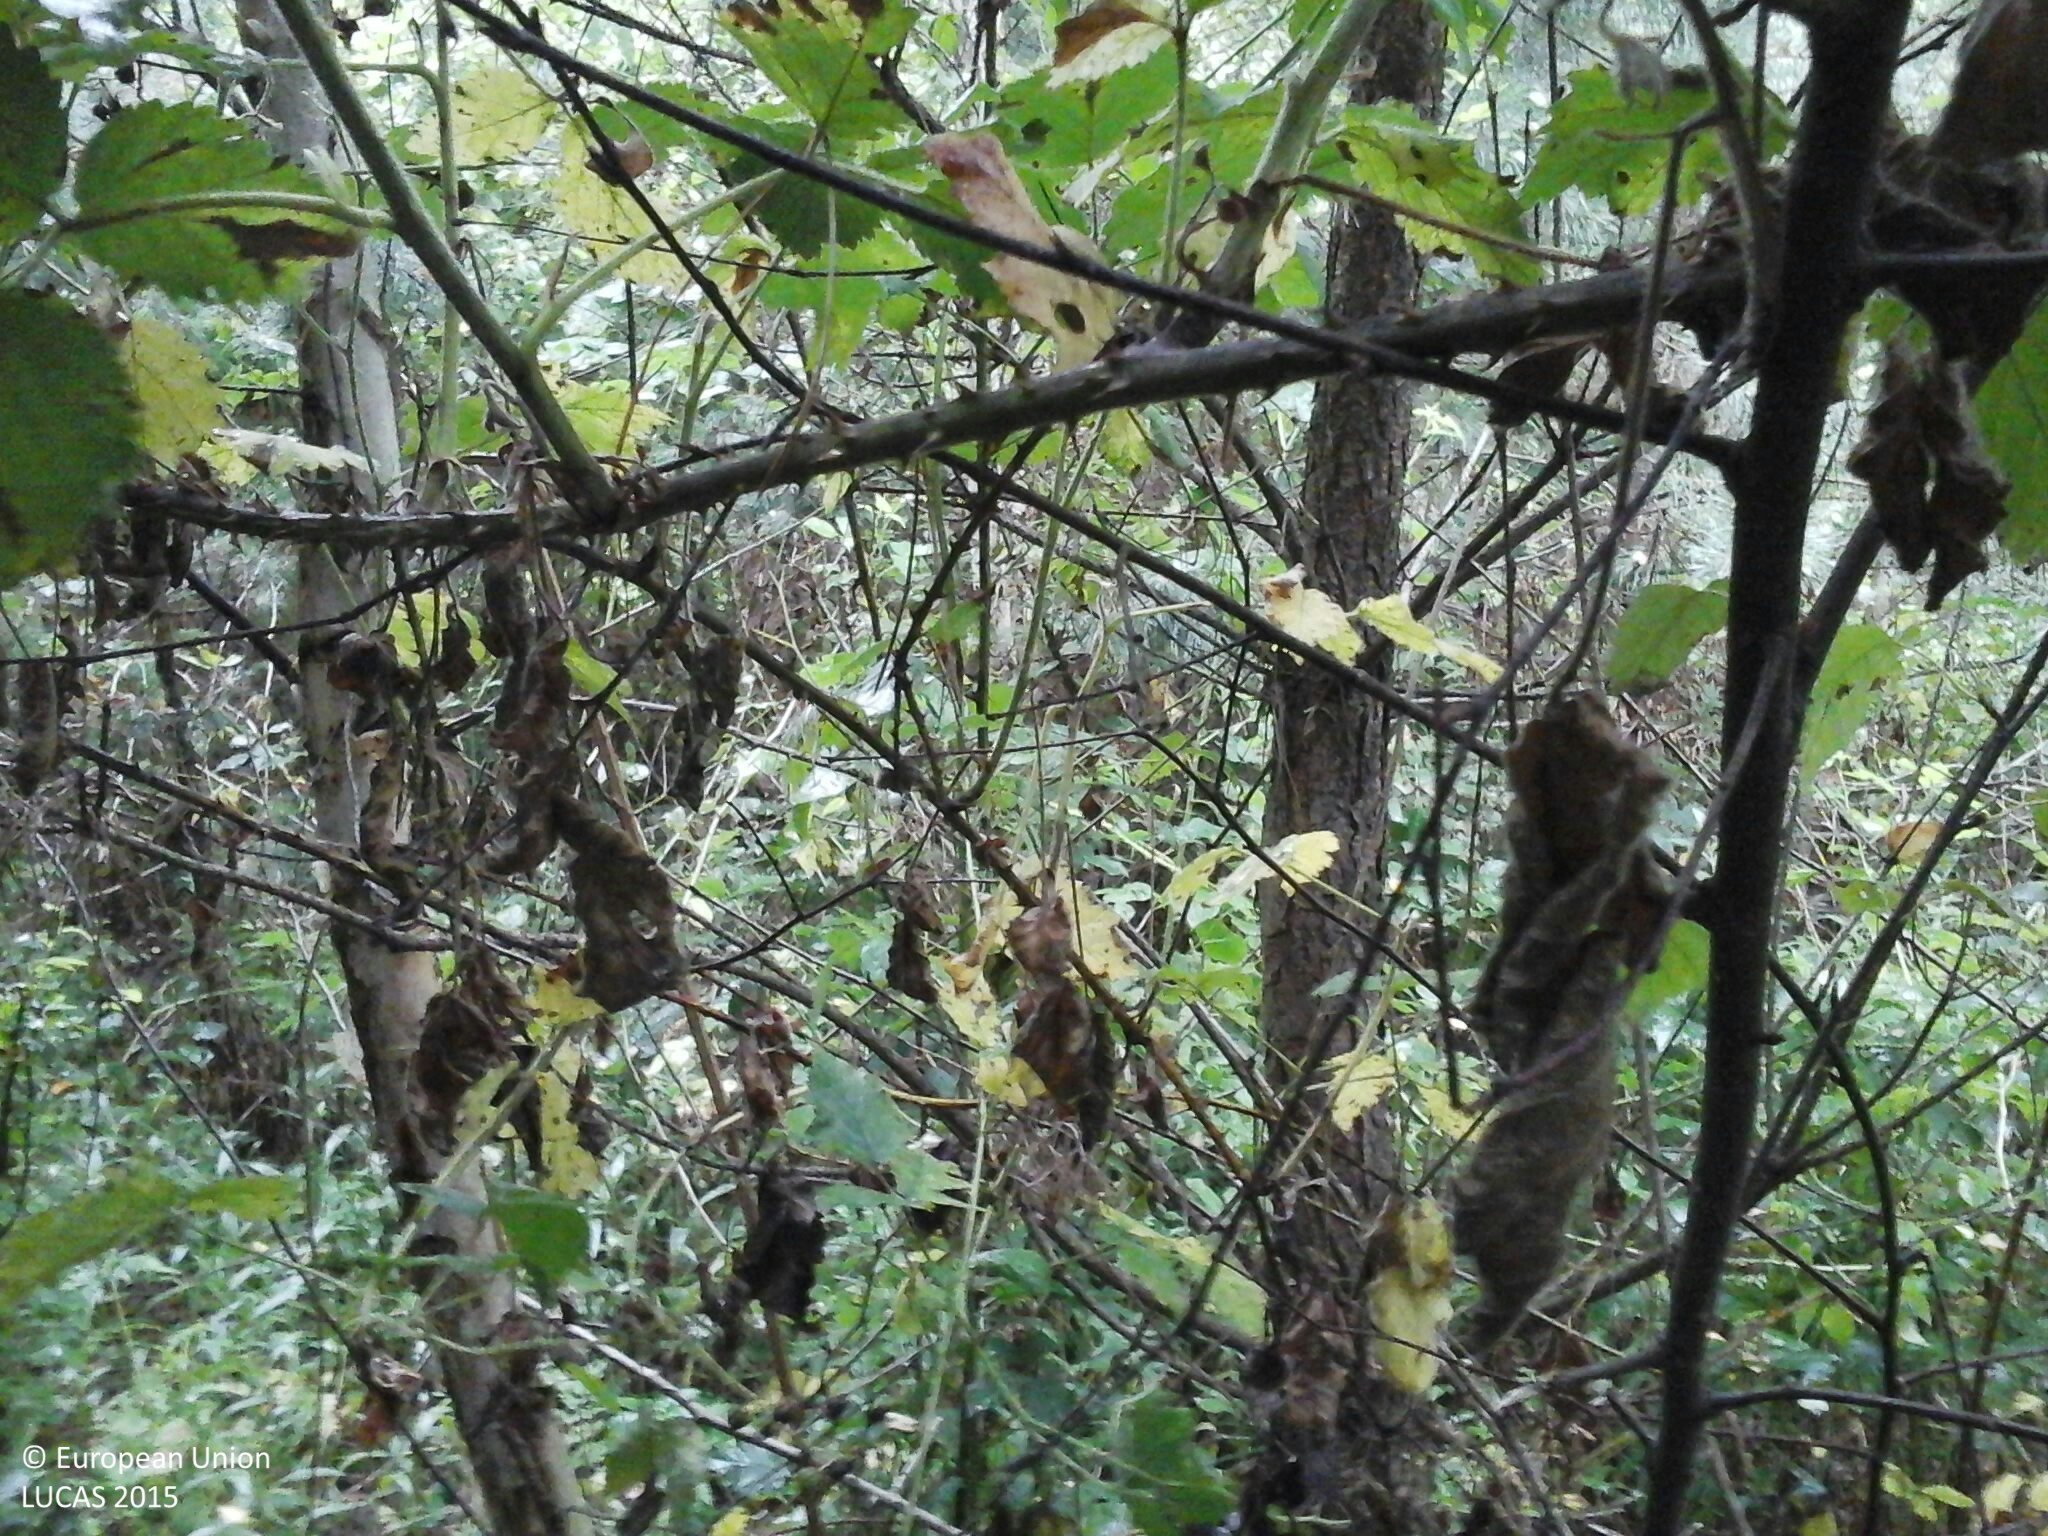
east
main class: Woodland
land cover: Pine dominated coniferous woodland
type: hemiboreal forest and nemoral coniferous forest and mixed broadleaved-coniferous forest
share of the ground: 50 - 75 %
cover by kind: coniferous forest trees 55 %, shrubs 20 %, broadleaved forest trees 15 %, herbaceous plants 10 %
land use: Forestry
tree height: < 5 m
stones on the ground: < 10 %
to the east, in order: Pine dominated coniferous woodland; Tracks; Pine dominated coniferous woodland; Tracks; Pine dominated coniferous woodland; Tracks; Pine dominated coniferous woodland
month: July
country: HU
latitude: 46.7866
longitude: 16.4860
